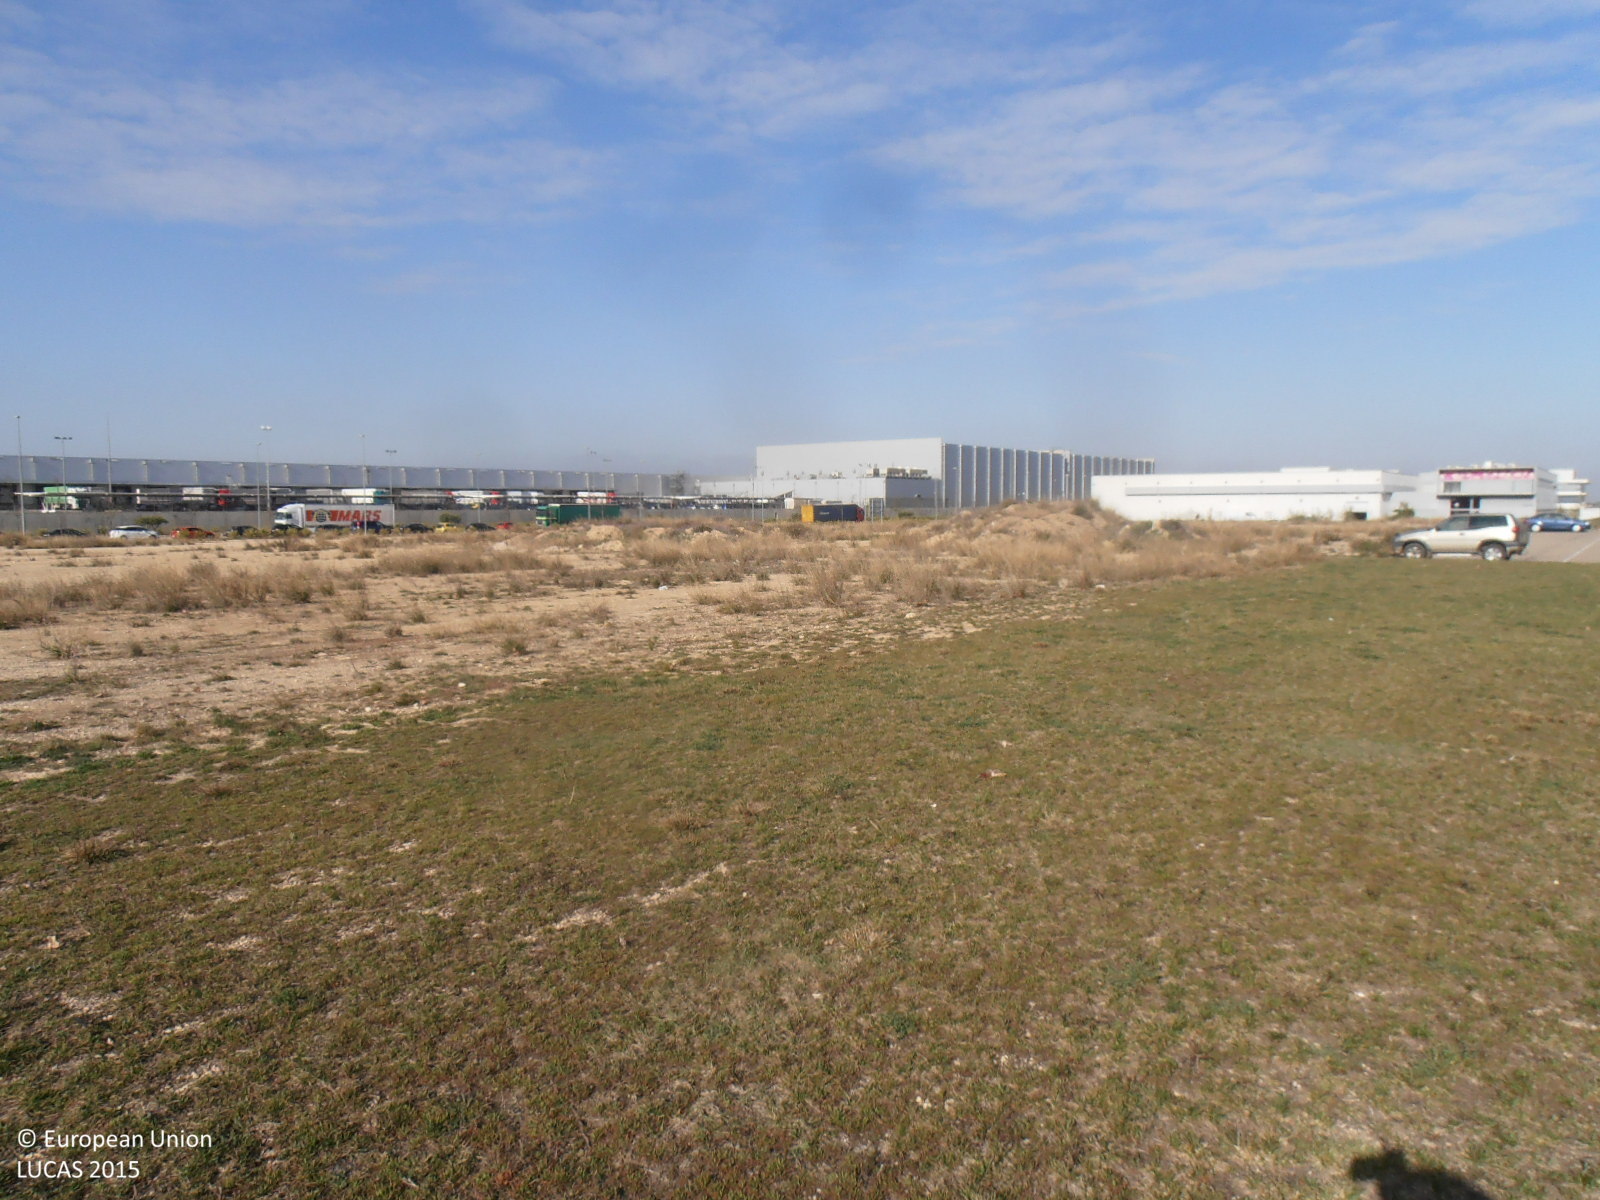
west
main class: Grassland
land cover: Grassland with sparse tree/shrub cover
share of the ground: > 75 %
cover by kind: herbaceous plants 95 %, broadleaved forest trees 5 %
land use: Sport
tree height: < 5 m
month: April
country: ES
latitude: 41.6539
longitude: -0.9859
